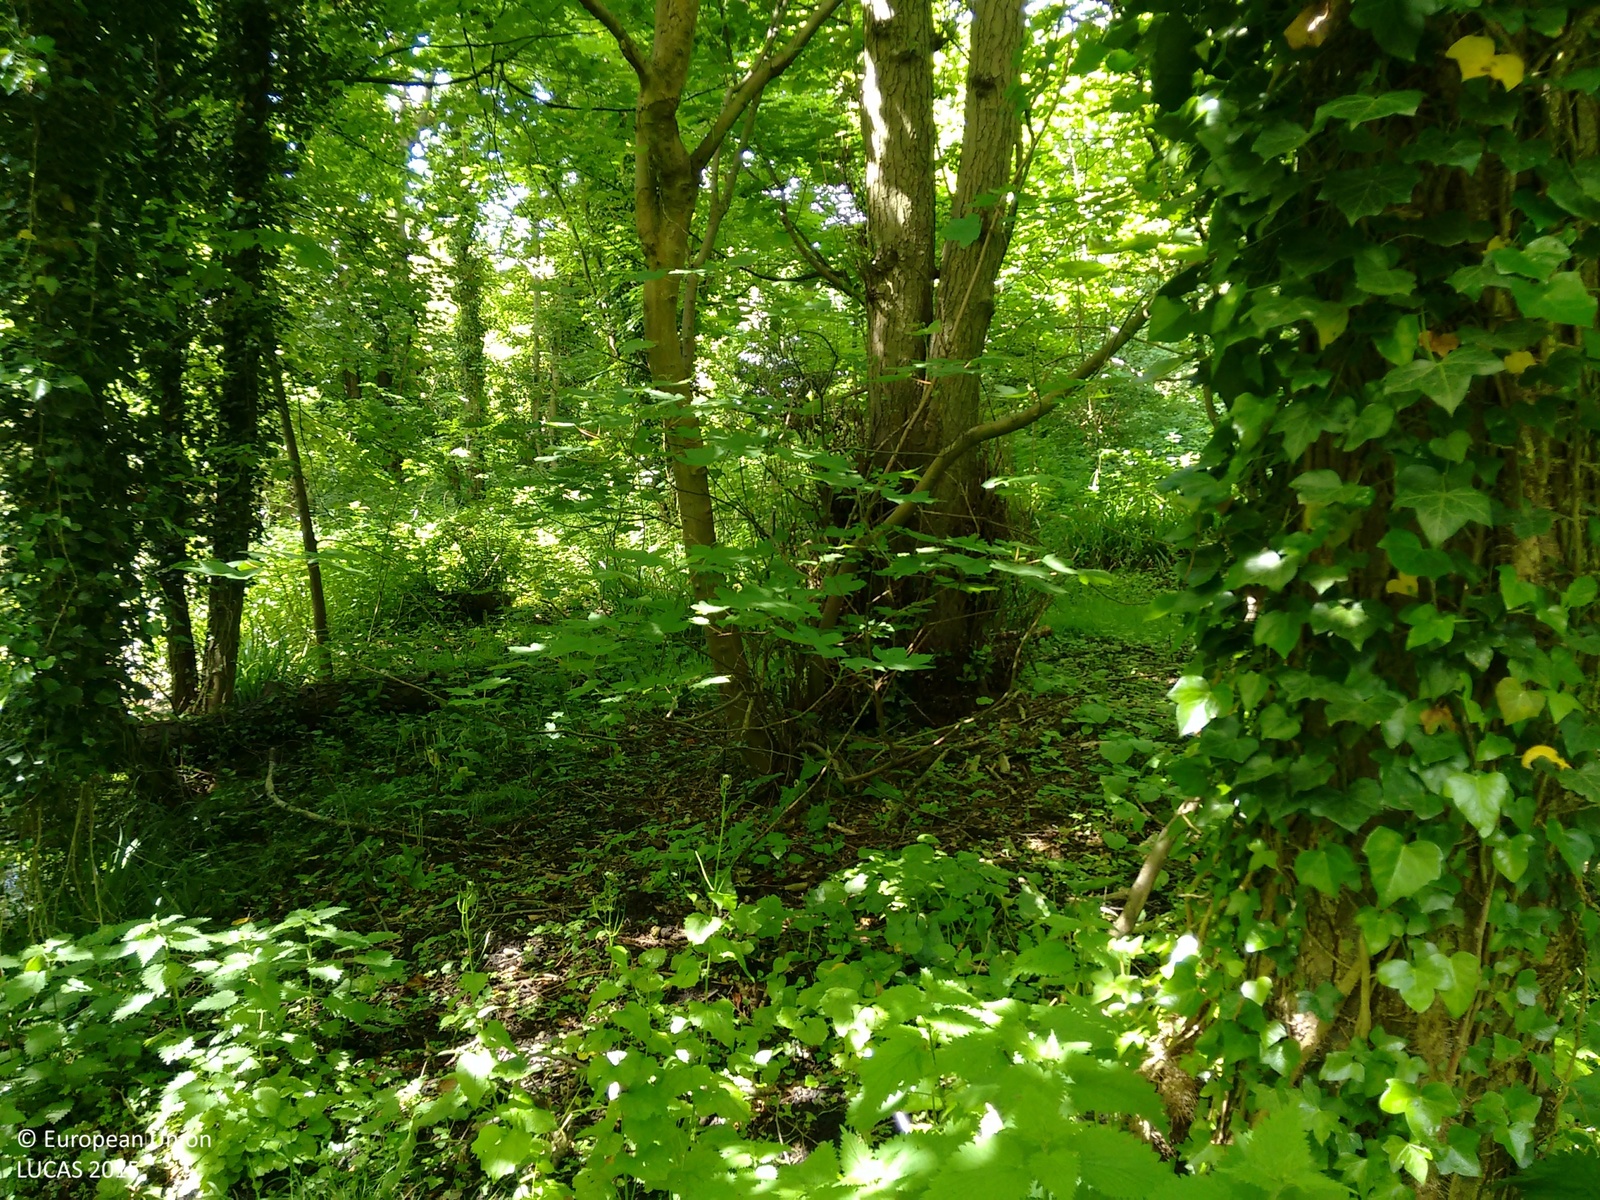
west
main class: Woodland
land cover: Broadleaved woodland
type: mesophytic deciduous forest
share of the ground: > 75 %
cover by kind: broadleaved forest trees 80 %, shrubs 10 %, herbaceous plants 10 %
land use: Amenities, museums, leisure
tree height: > 5 m
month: May
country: GB
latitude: 52.0891
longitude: -0.3257
